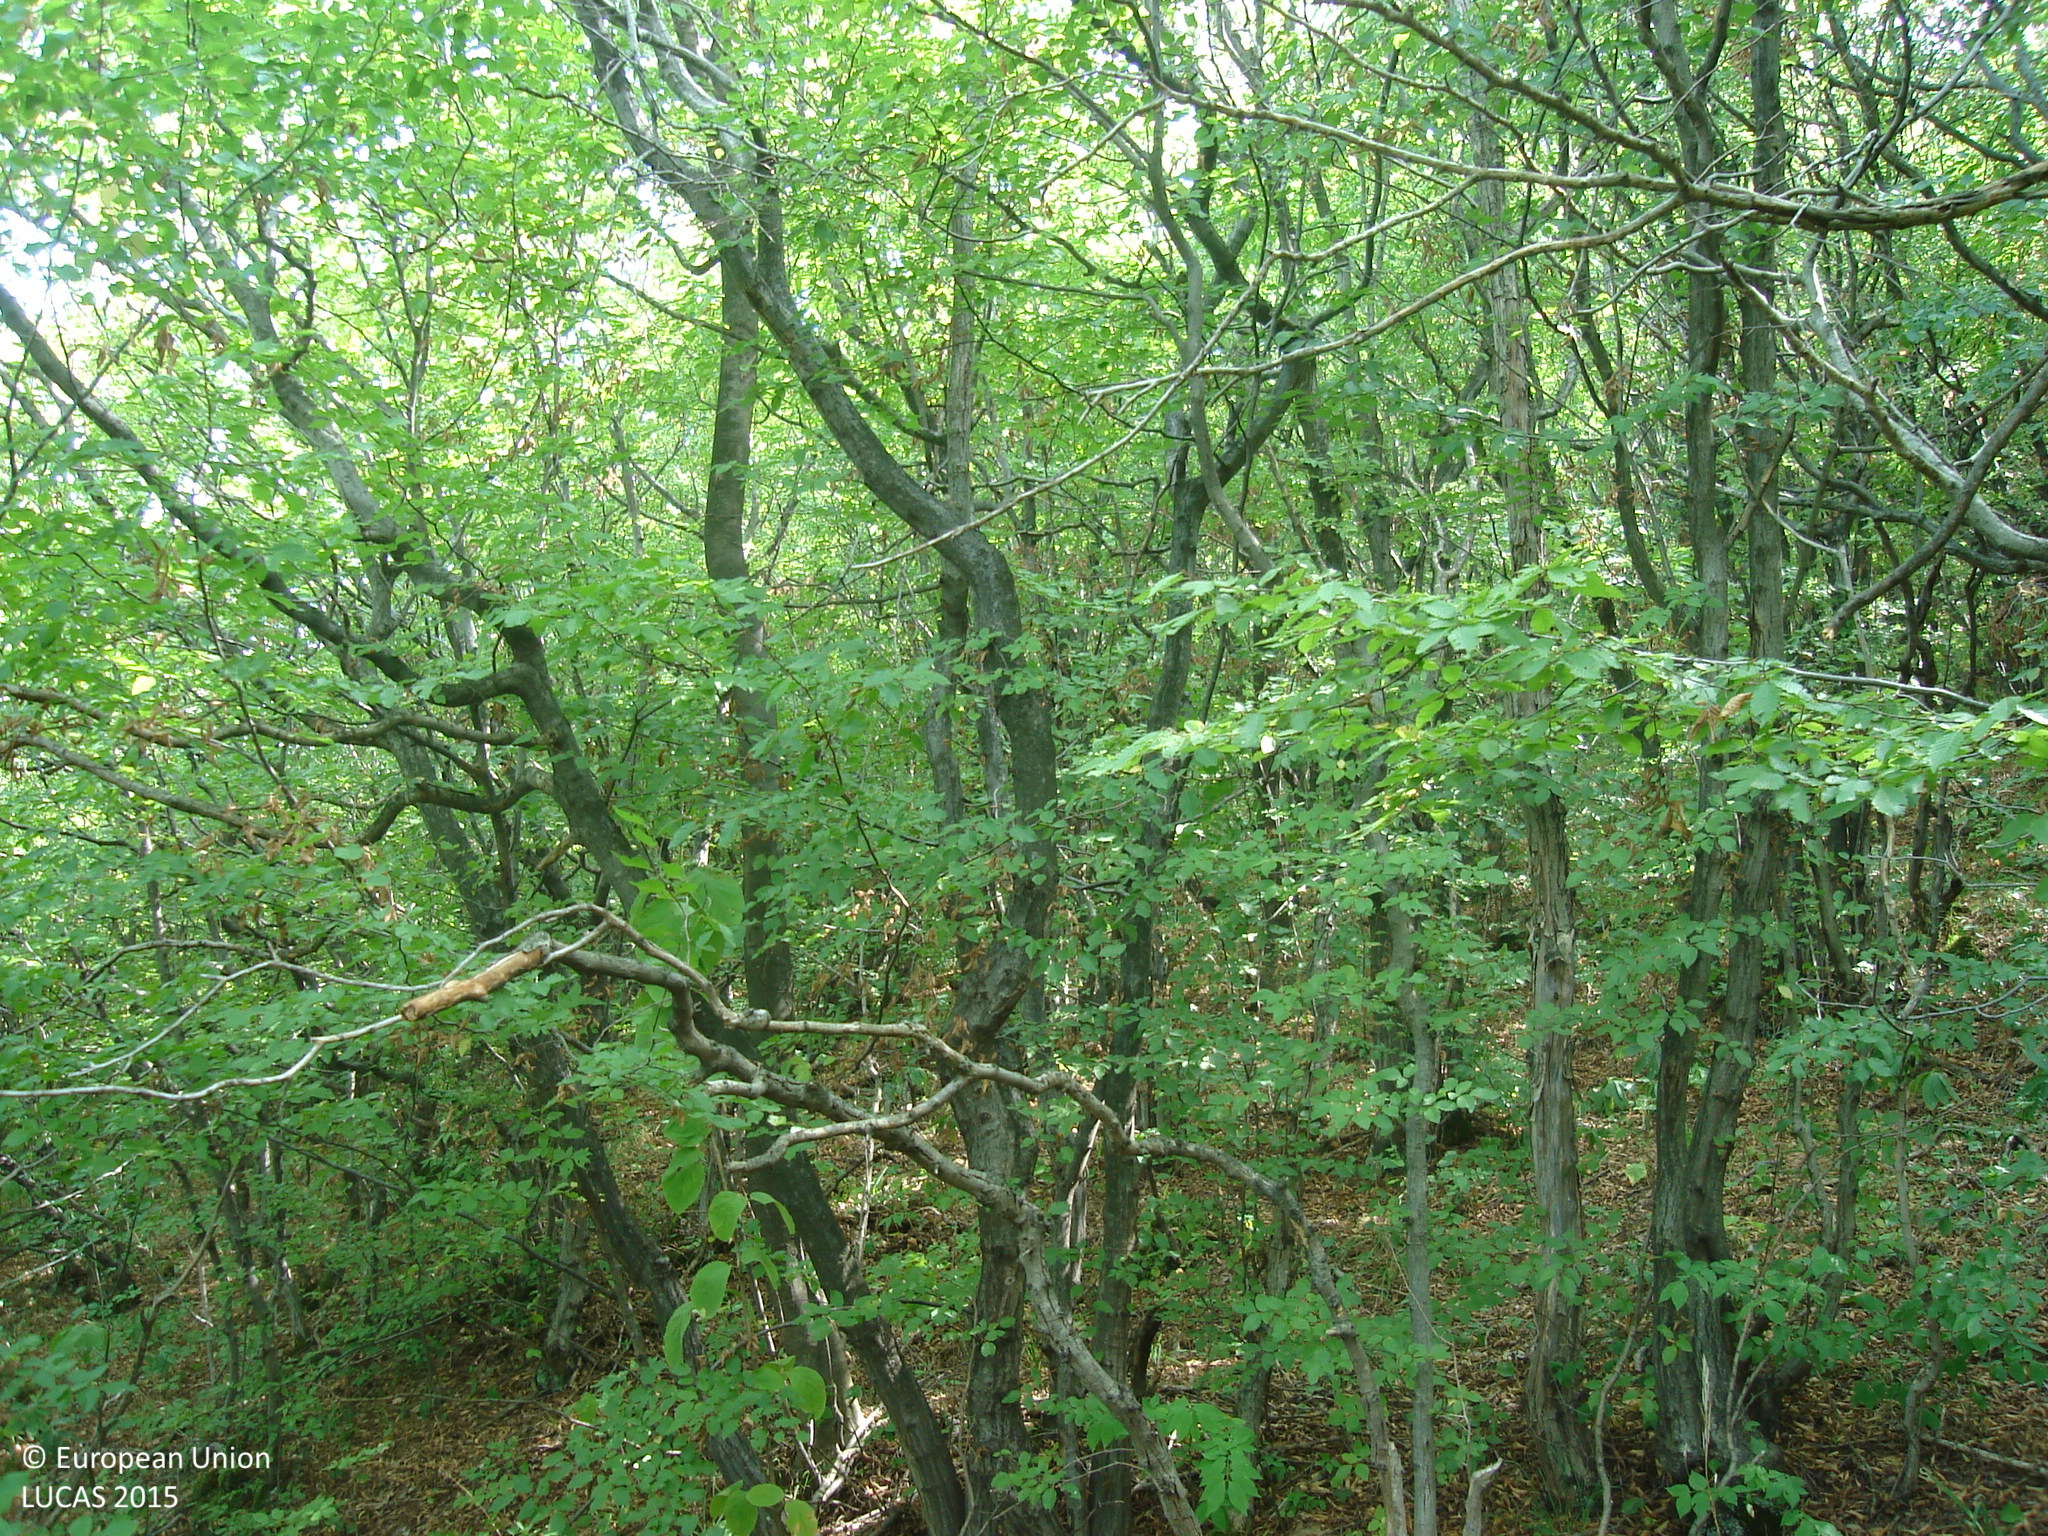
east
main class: Woodland
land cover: Broadleaved woodland
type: beech forest
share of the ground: > 75 %
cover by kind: broadleaved forest trees 85 %, consolidated bare surface 15 %
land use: Forestry
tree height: > 5 m
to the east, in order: Broadleaved woodland
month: September
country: BG
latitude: 42.6371
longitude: 23.9333
